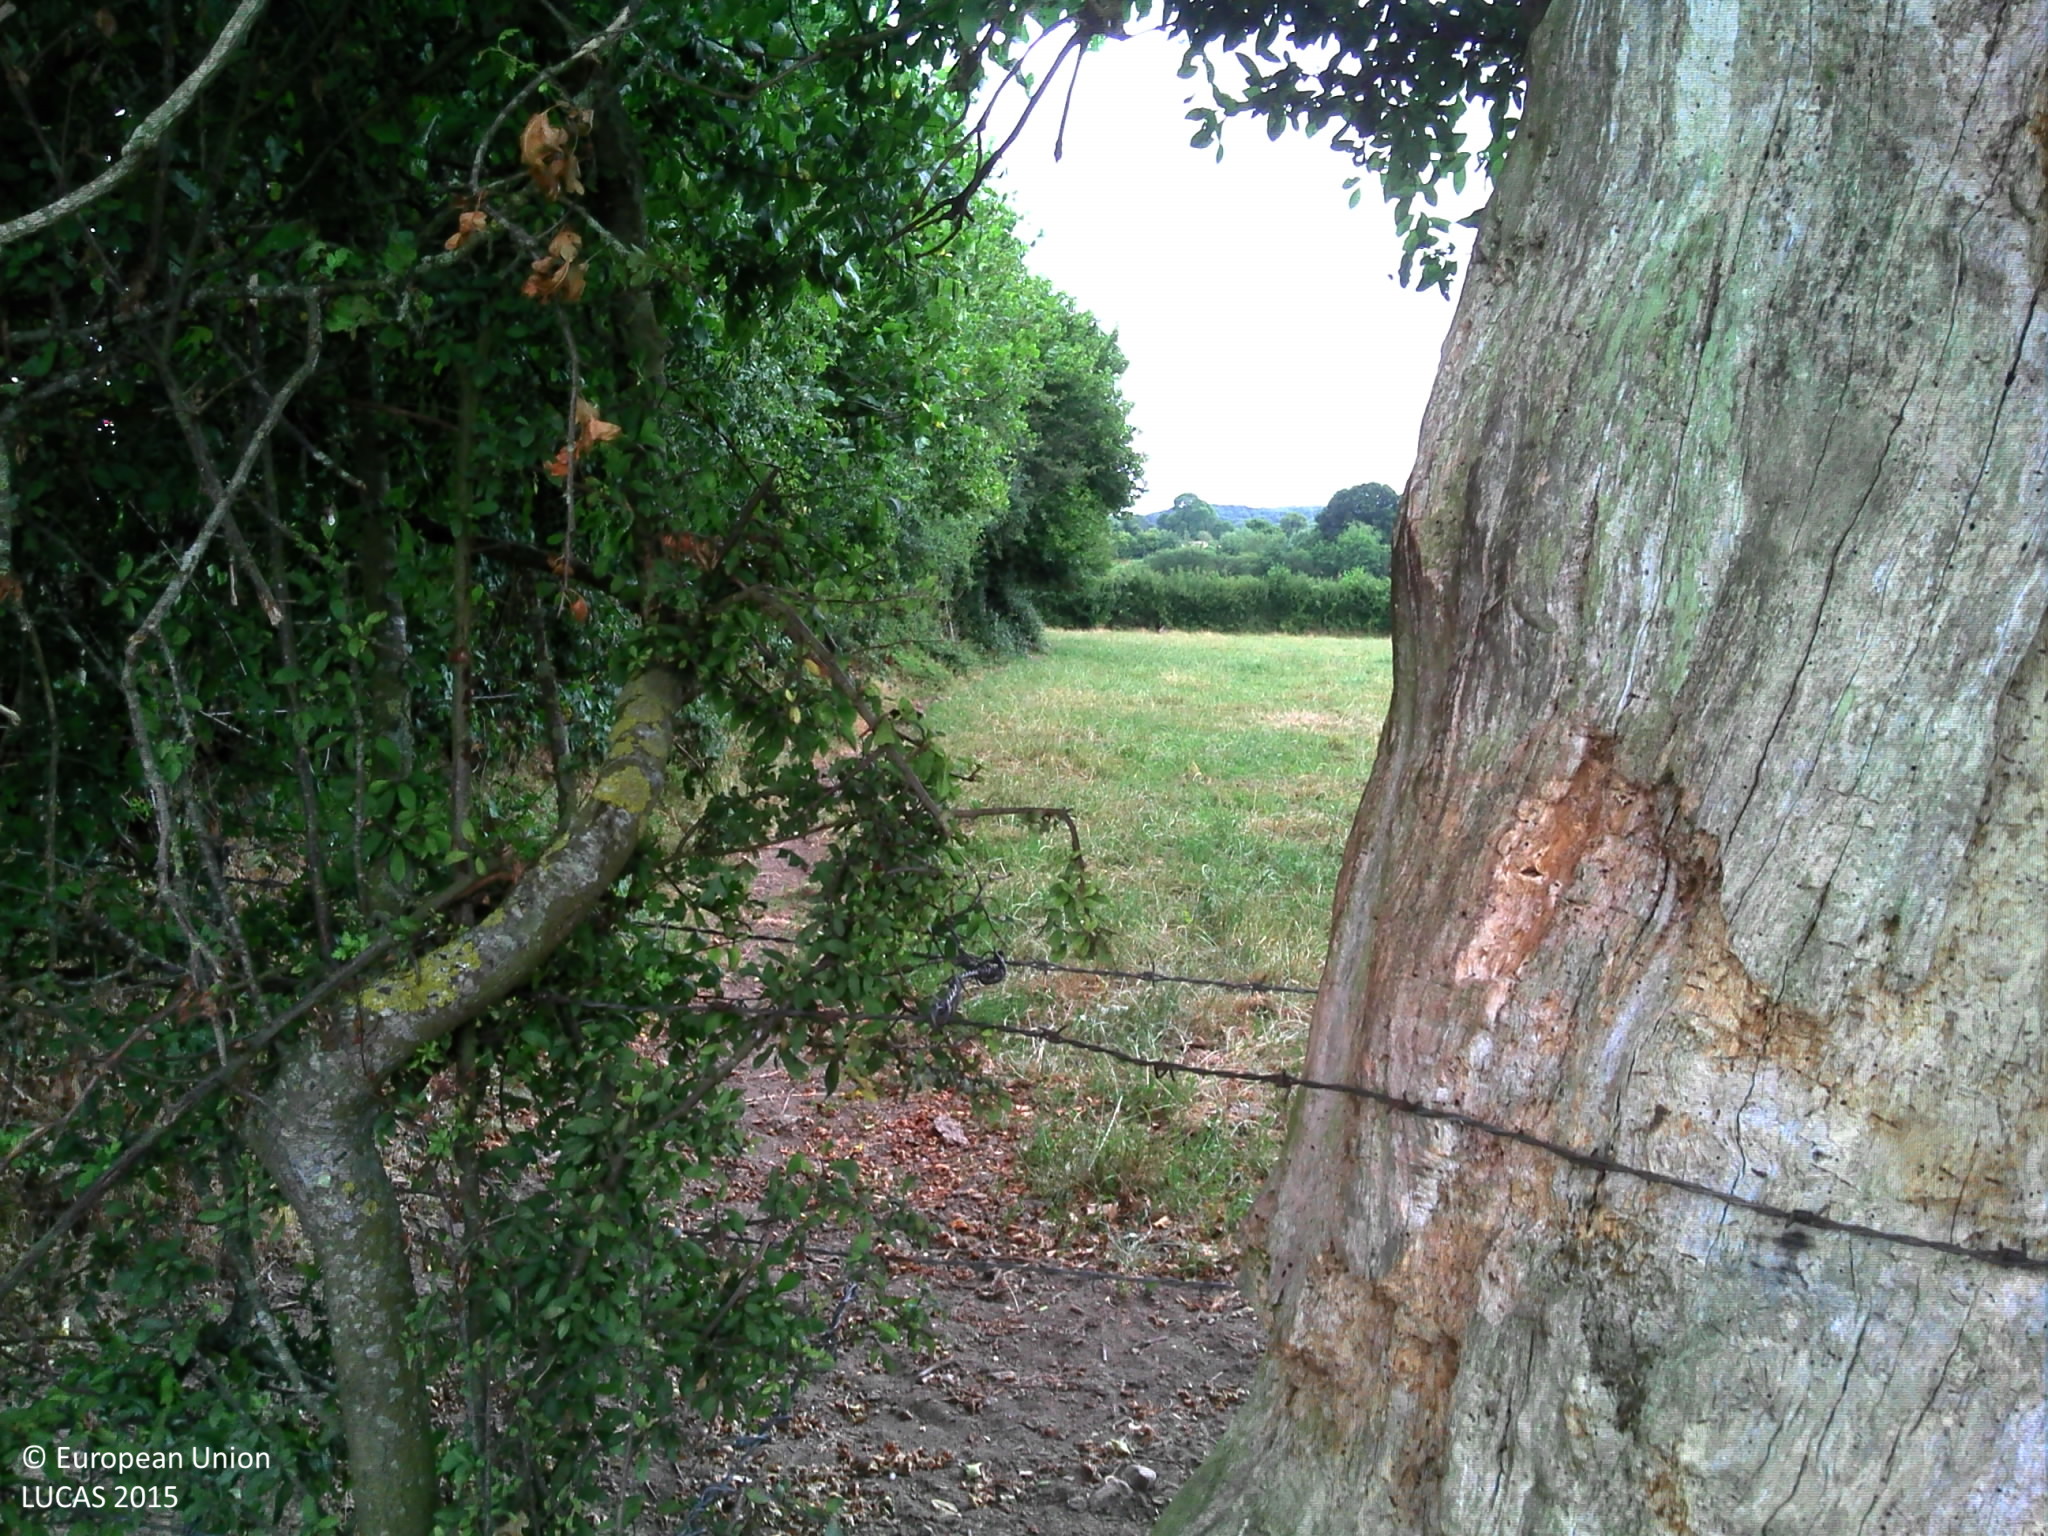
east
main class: Grassland
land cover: Grassland without tree/shrub cover
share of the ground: > 75 %
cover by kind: herbaceous plants 100 %
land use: Agriculture (excluding fallow land and kitchen gardens)
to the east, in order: Grassland without tree/shrub cover; Fences; Managed hedges; Fences; Grassland without tree/shrub cover; Fences; Maize; Spontaneously vegetated surfaces
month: July
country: FR
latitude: 48.4117
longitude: -0.0954
